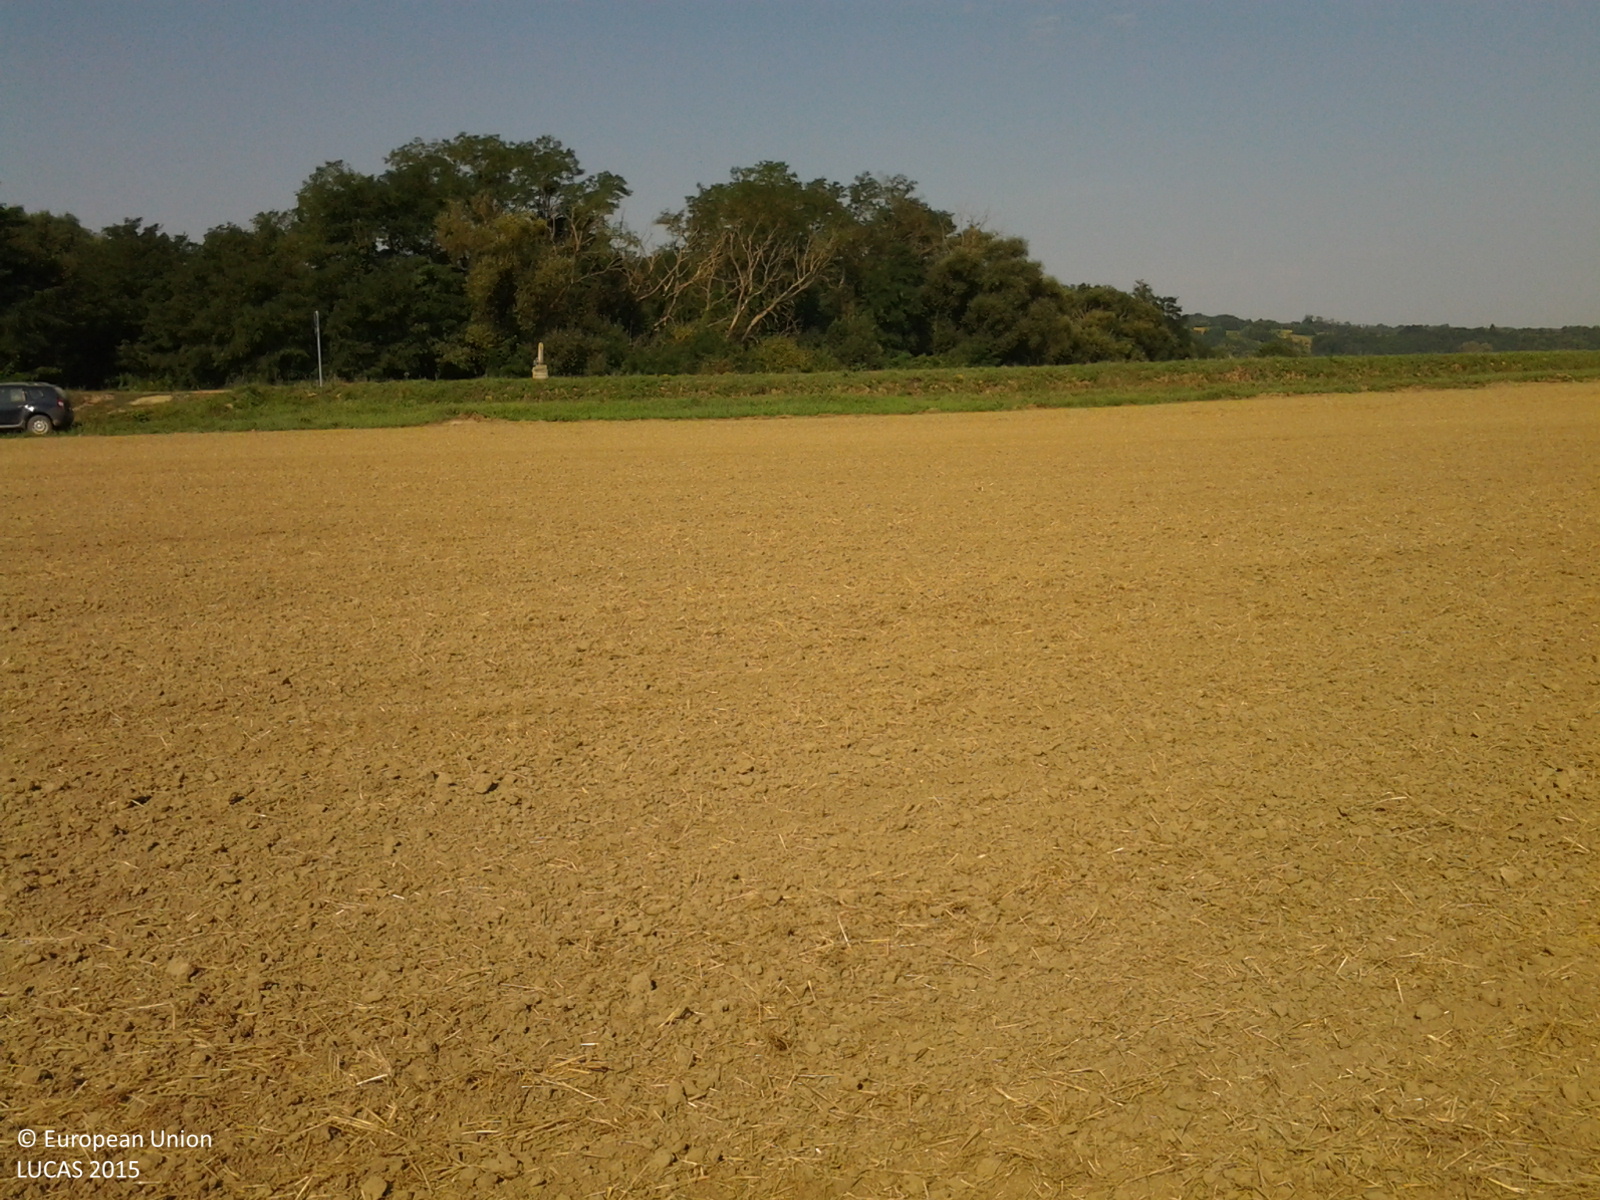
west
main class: Cropland
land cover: Oats
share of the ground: < 10 %
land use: Agriculture (excluding fallow land and kitchen gardens)
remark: Harvested field
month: August
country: HU
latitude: 46.6054
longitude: 17.0664
